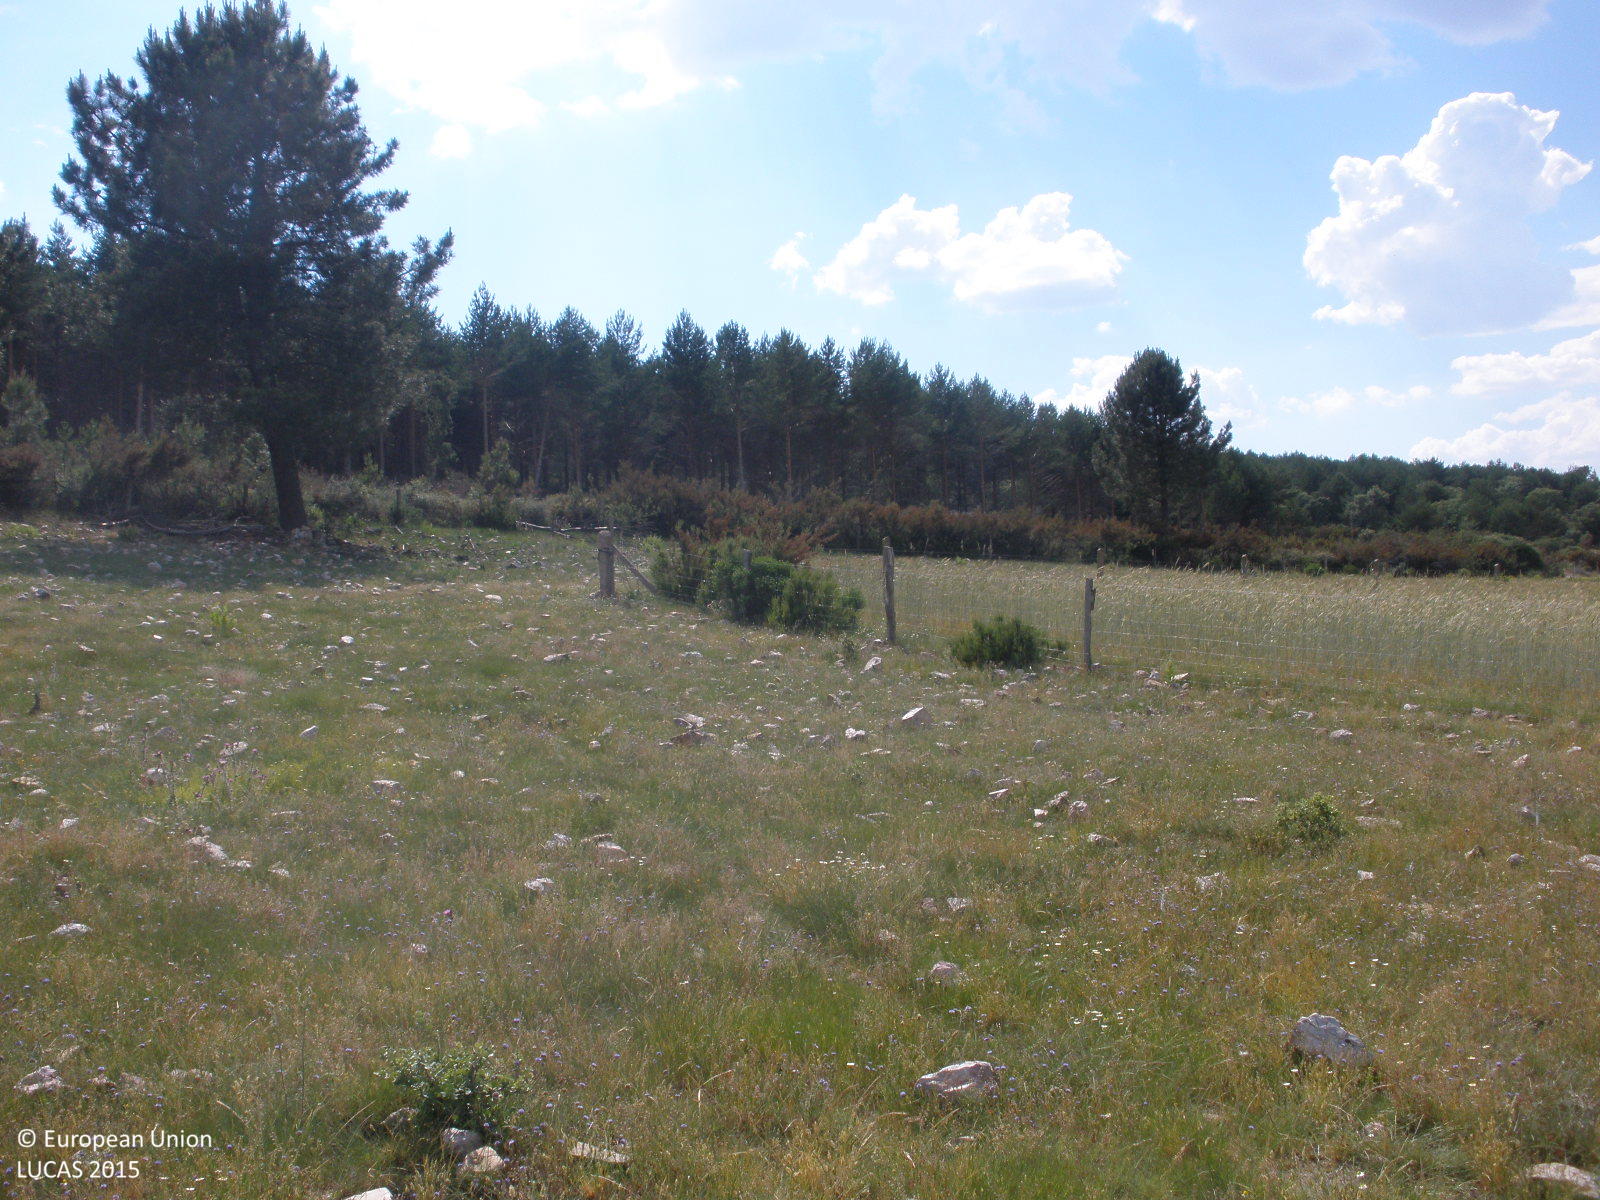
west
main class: Grassland
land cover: Grassland with sparse tree/shrub cover
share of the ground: > 75 %
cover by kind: herbaceous plants 95 %, broadleaved forest trees 5 %
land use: Agriculture (excluding fallow land and kitchen gardens)
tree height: < 5 m
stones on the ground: 10 - 25 %
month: June
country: ES
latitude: 40.5511
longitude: -6.2974
